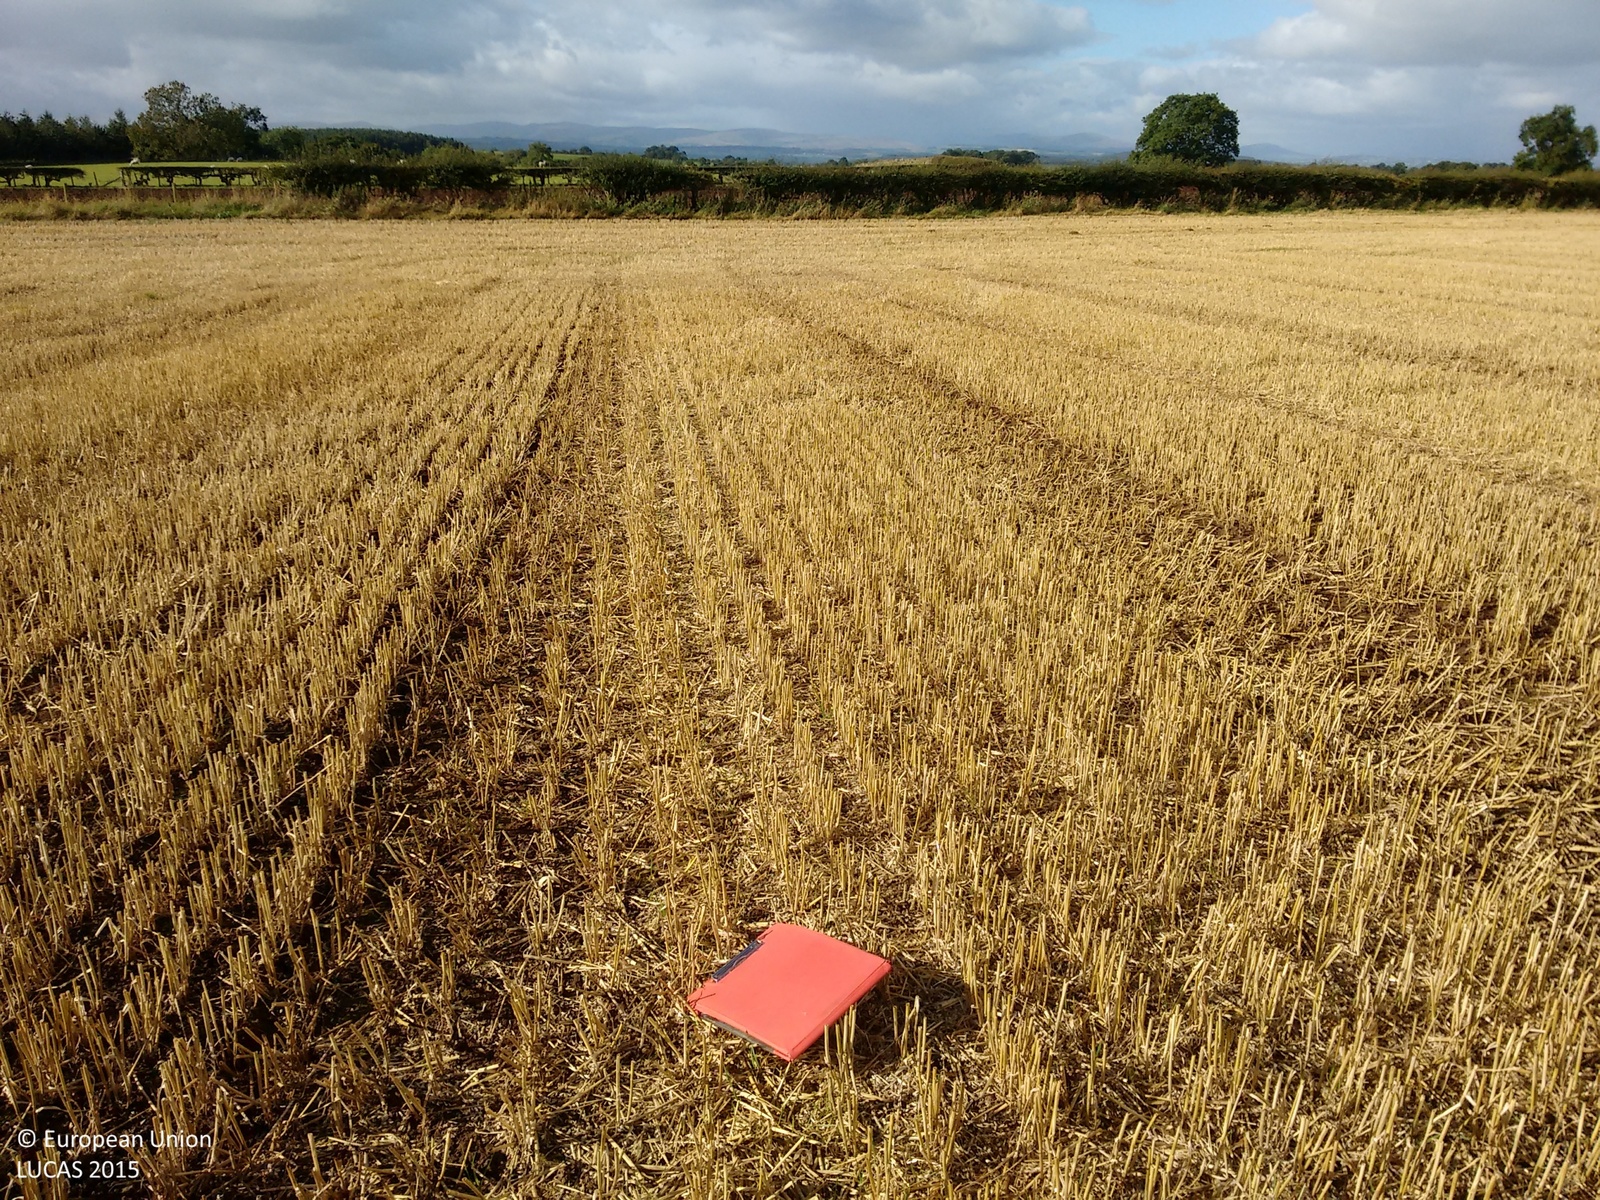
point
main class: Cropland
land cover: Barley
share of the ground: > 75 %
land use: Agriculture (excluding fallow land and kitchen gardens)
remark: Harvested field
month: September
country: GB
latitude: 54.6585
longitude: -2.5428
